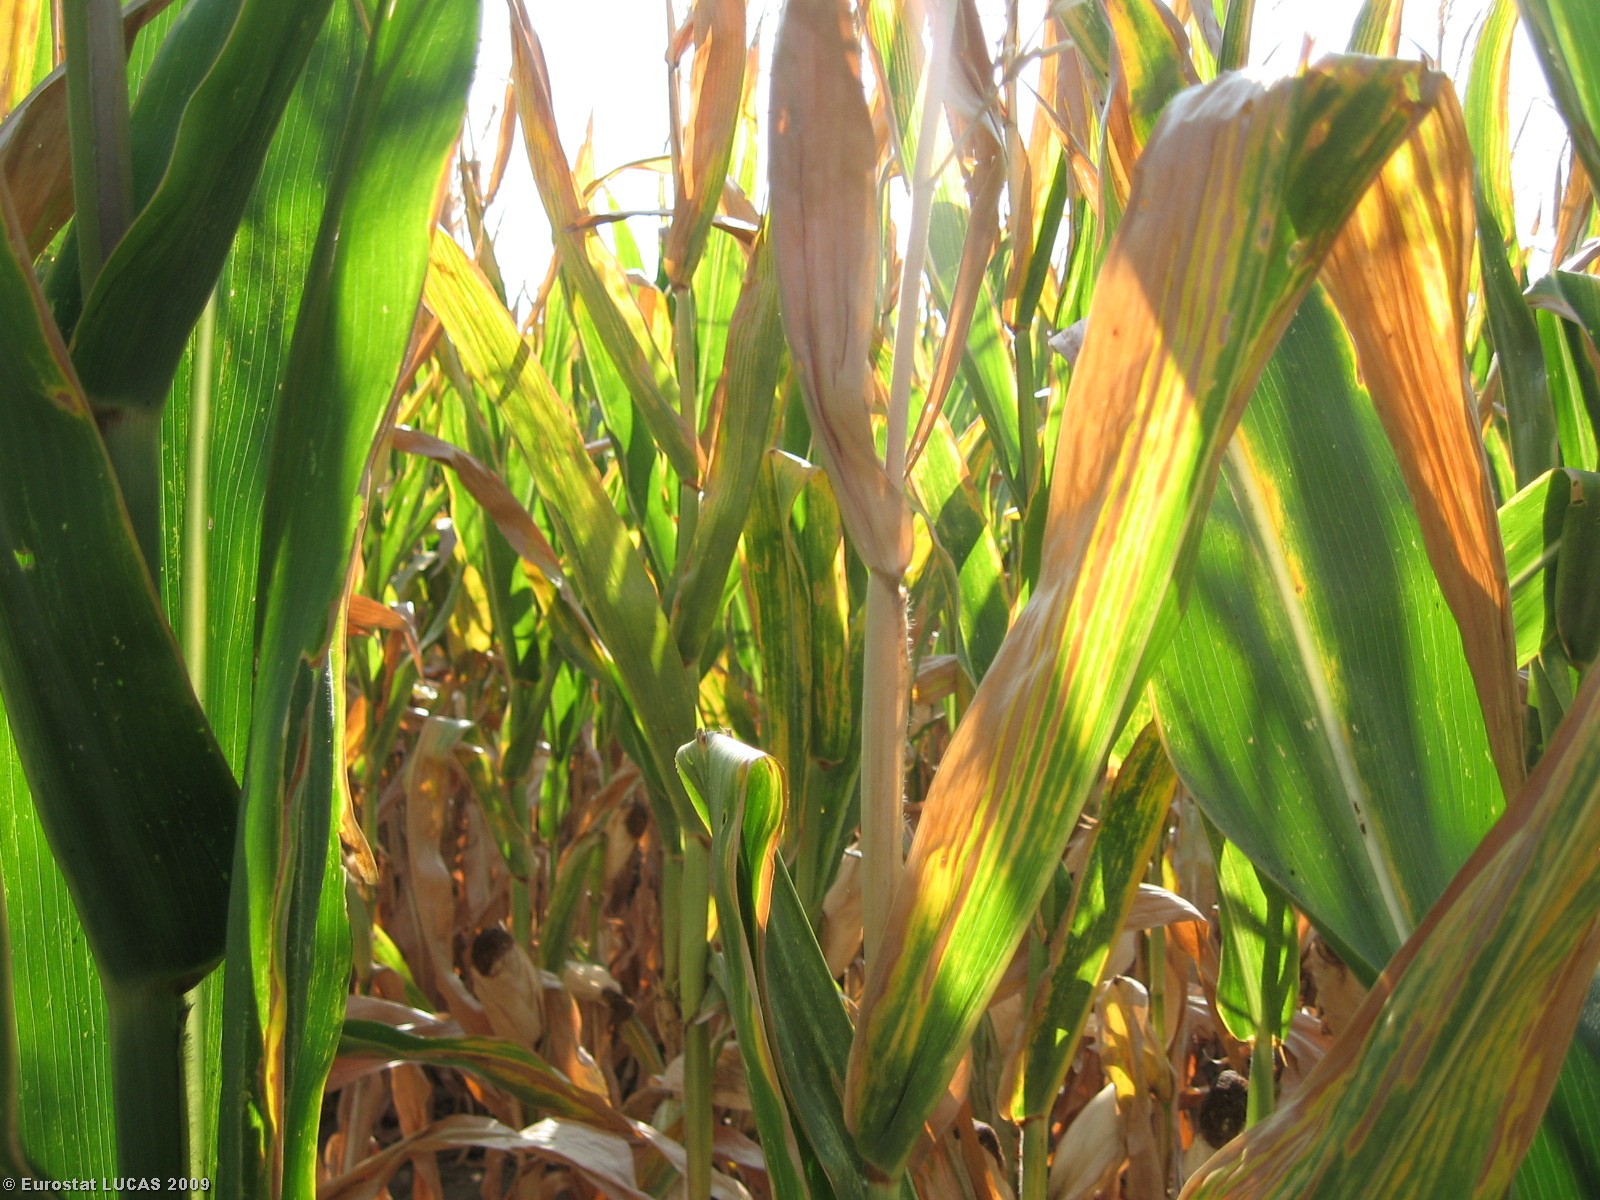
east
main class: Cropland
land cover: Maize
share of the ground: > 75 %
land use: Agriculture (excluding fallow land and kitchen gardens)
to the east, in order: Maize; Bare land
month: August
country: IT
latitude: 45.0177
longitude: 10.0380
